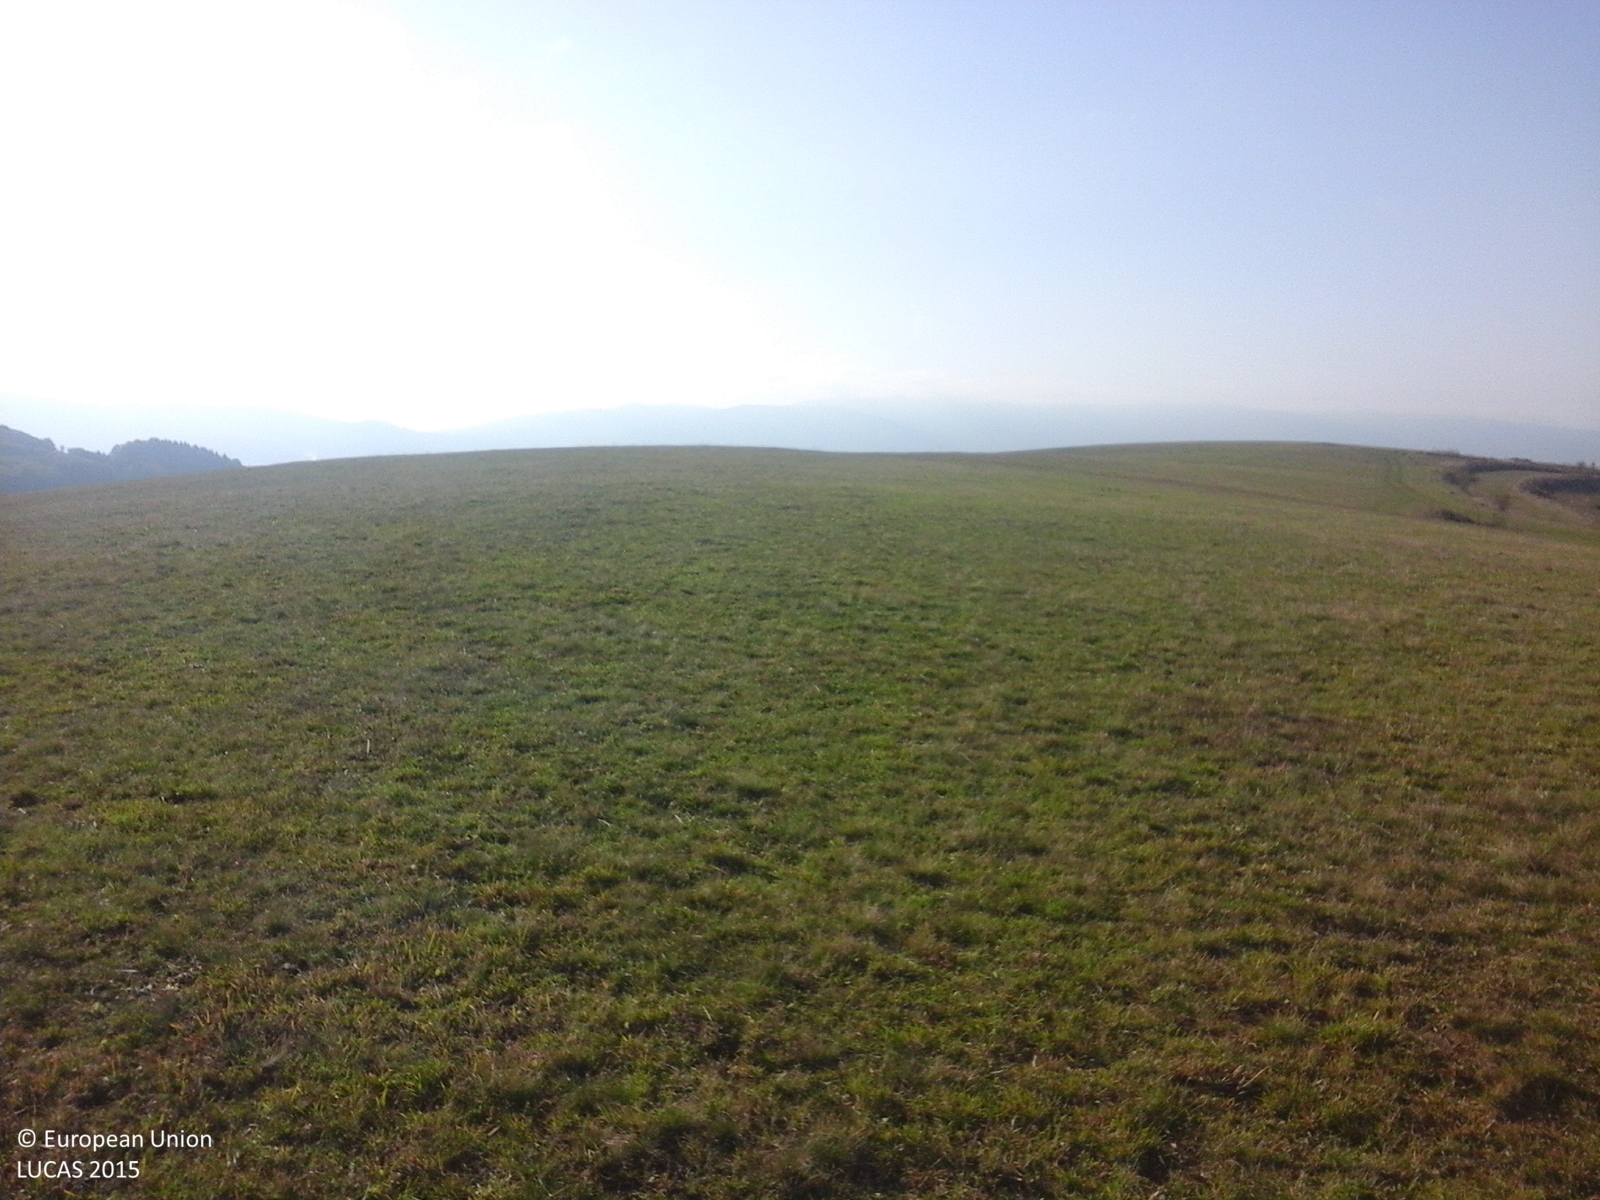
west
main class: Grassland
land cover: Grassland without tree/shrub cover
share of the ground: > 75 %
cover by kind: herbaceous plants 100 %
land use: Agriculture (excluding fallow land and kitchen gardens)
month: October
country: RO
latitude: 46.3867
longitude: 25.8637
